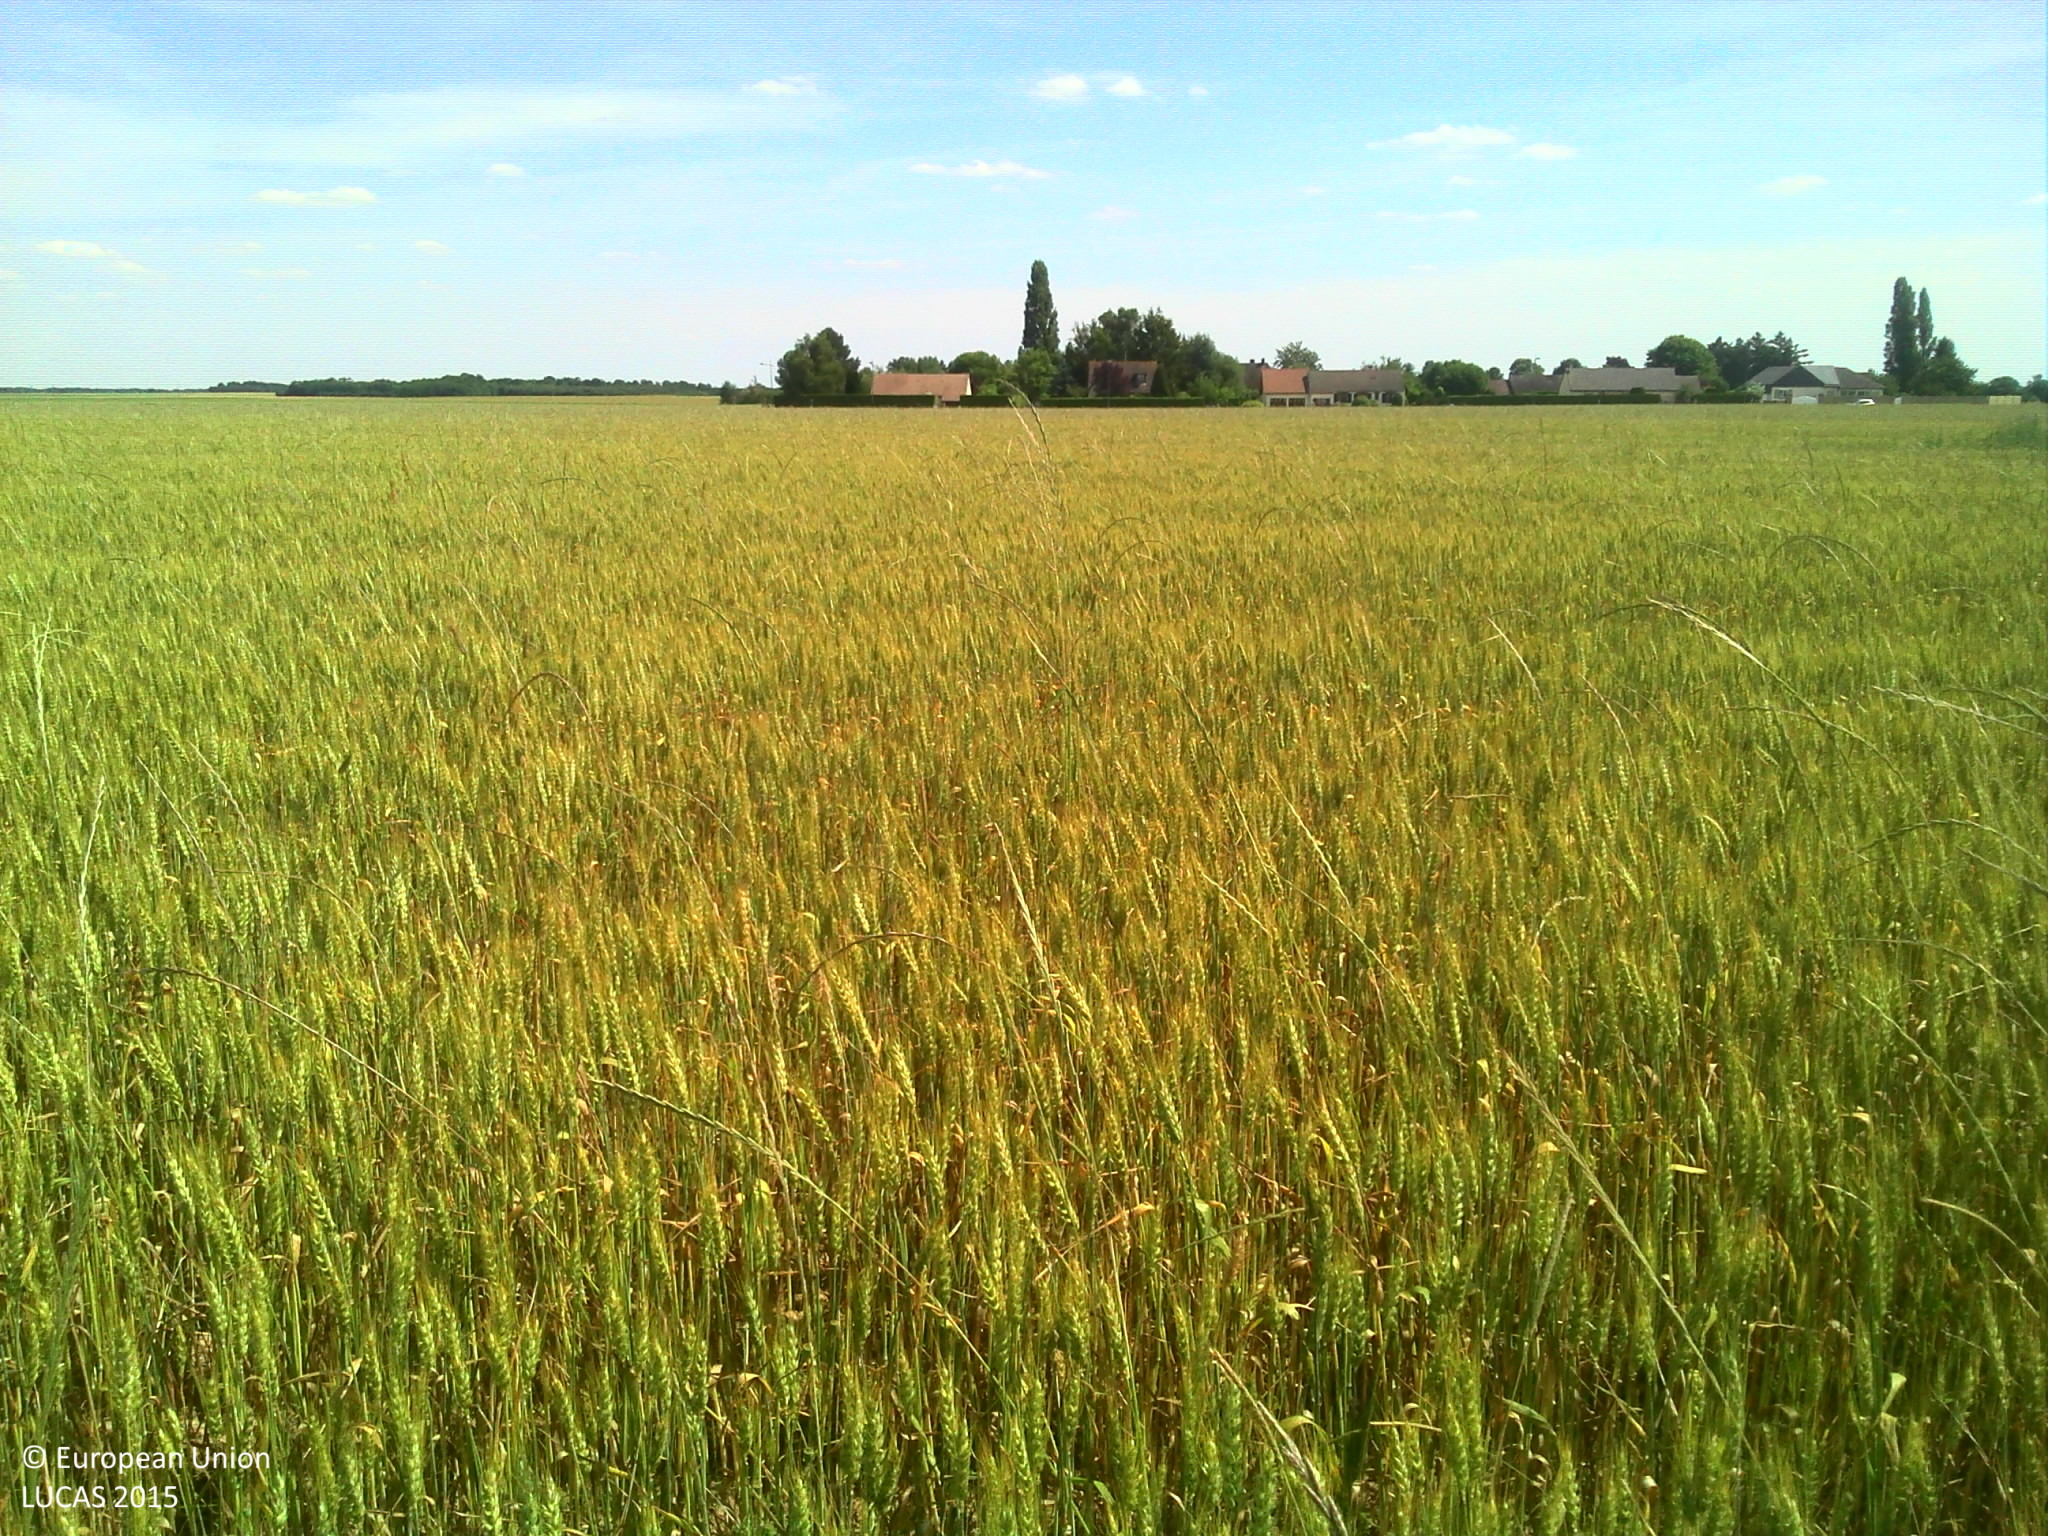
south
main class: Cropland
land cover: Common wheat
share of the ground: > 75 %
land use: Agriculture (excluding fallow land and kitchen gardens)
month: June
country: FR
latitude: 49.0730
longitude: 1.0673
